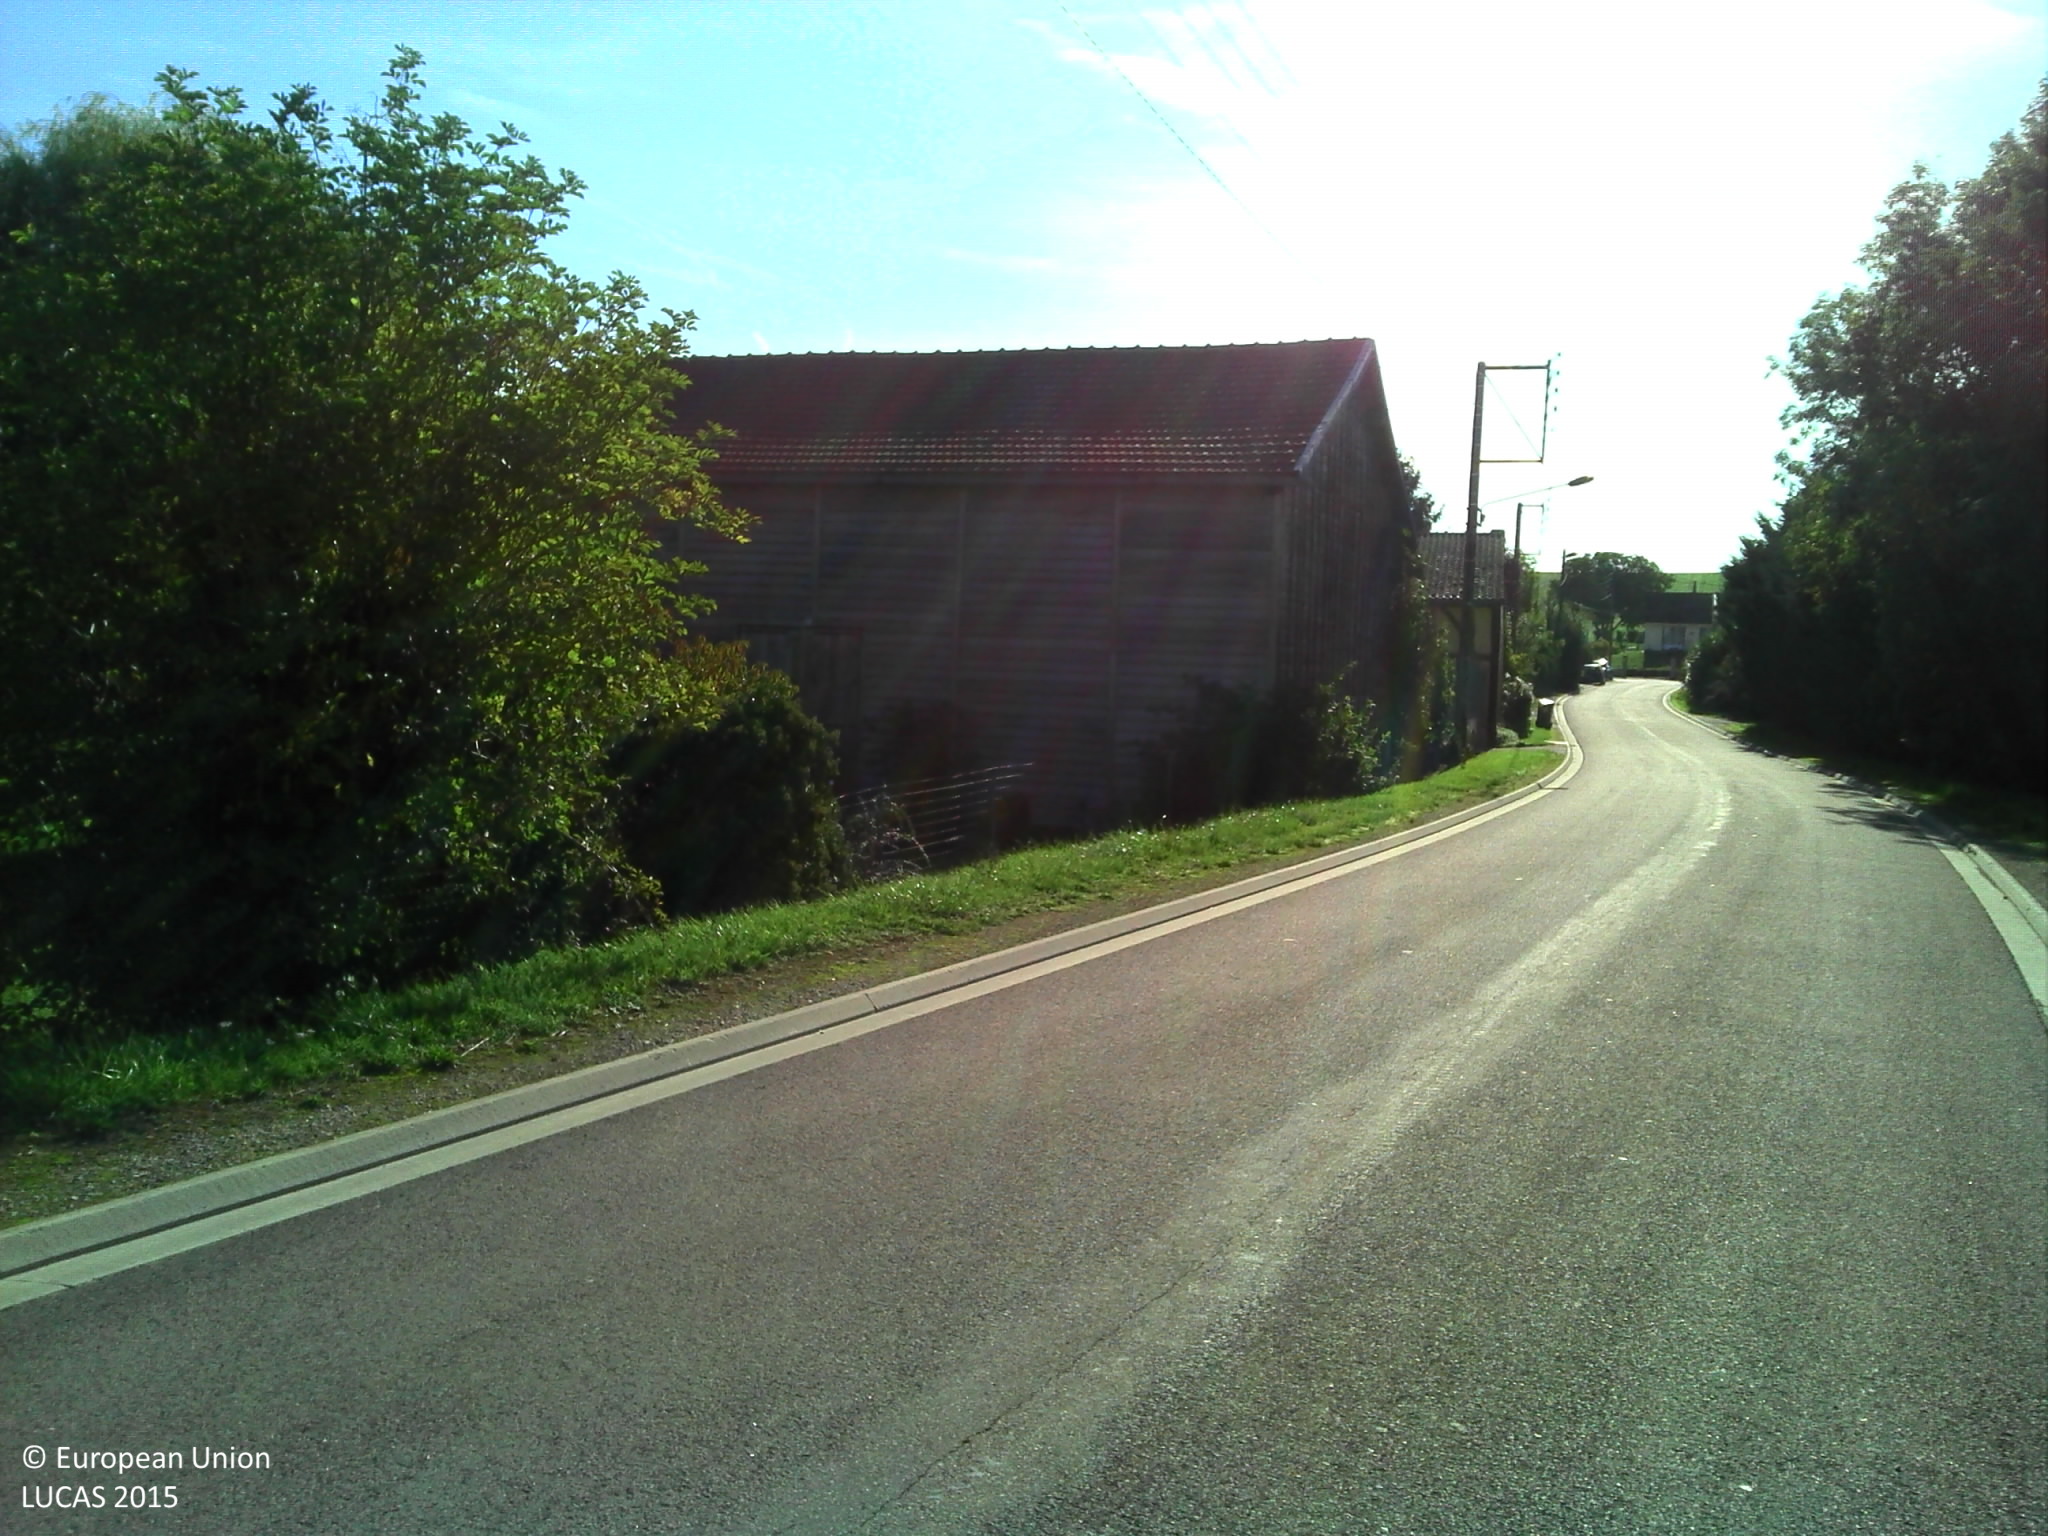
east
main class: Grassland
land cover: Grassland without tree/shrub cover
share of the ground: > 75 %
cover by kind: herbaceous plants 100 %
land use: Agriculture (excluding fallow land and kitchen gardens)
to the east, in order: Grassland without tree/shrub cover; Single bushes/trees; Grassland without tree/shrub cover; Fences; Broadleaved woodland; Artificial constructions in urban areas
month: September
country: FR
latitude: 48.4041
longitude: 4.3641
